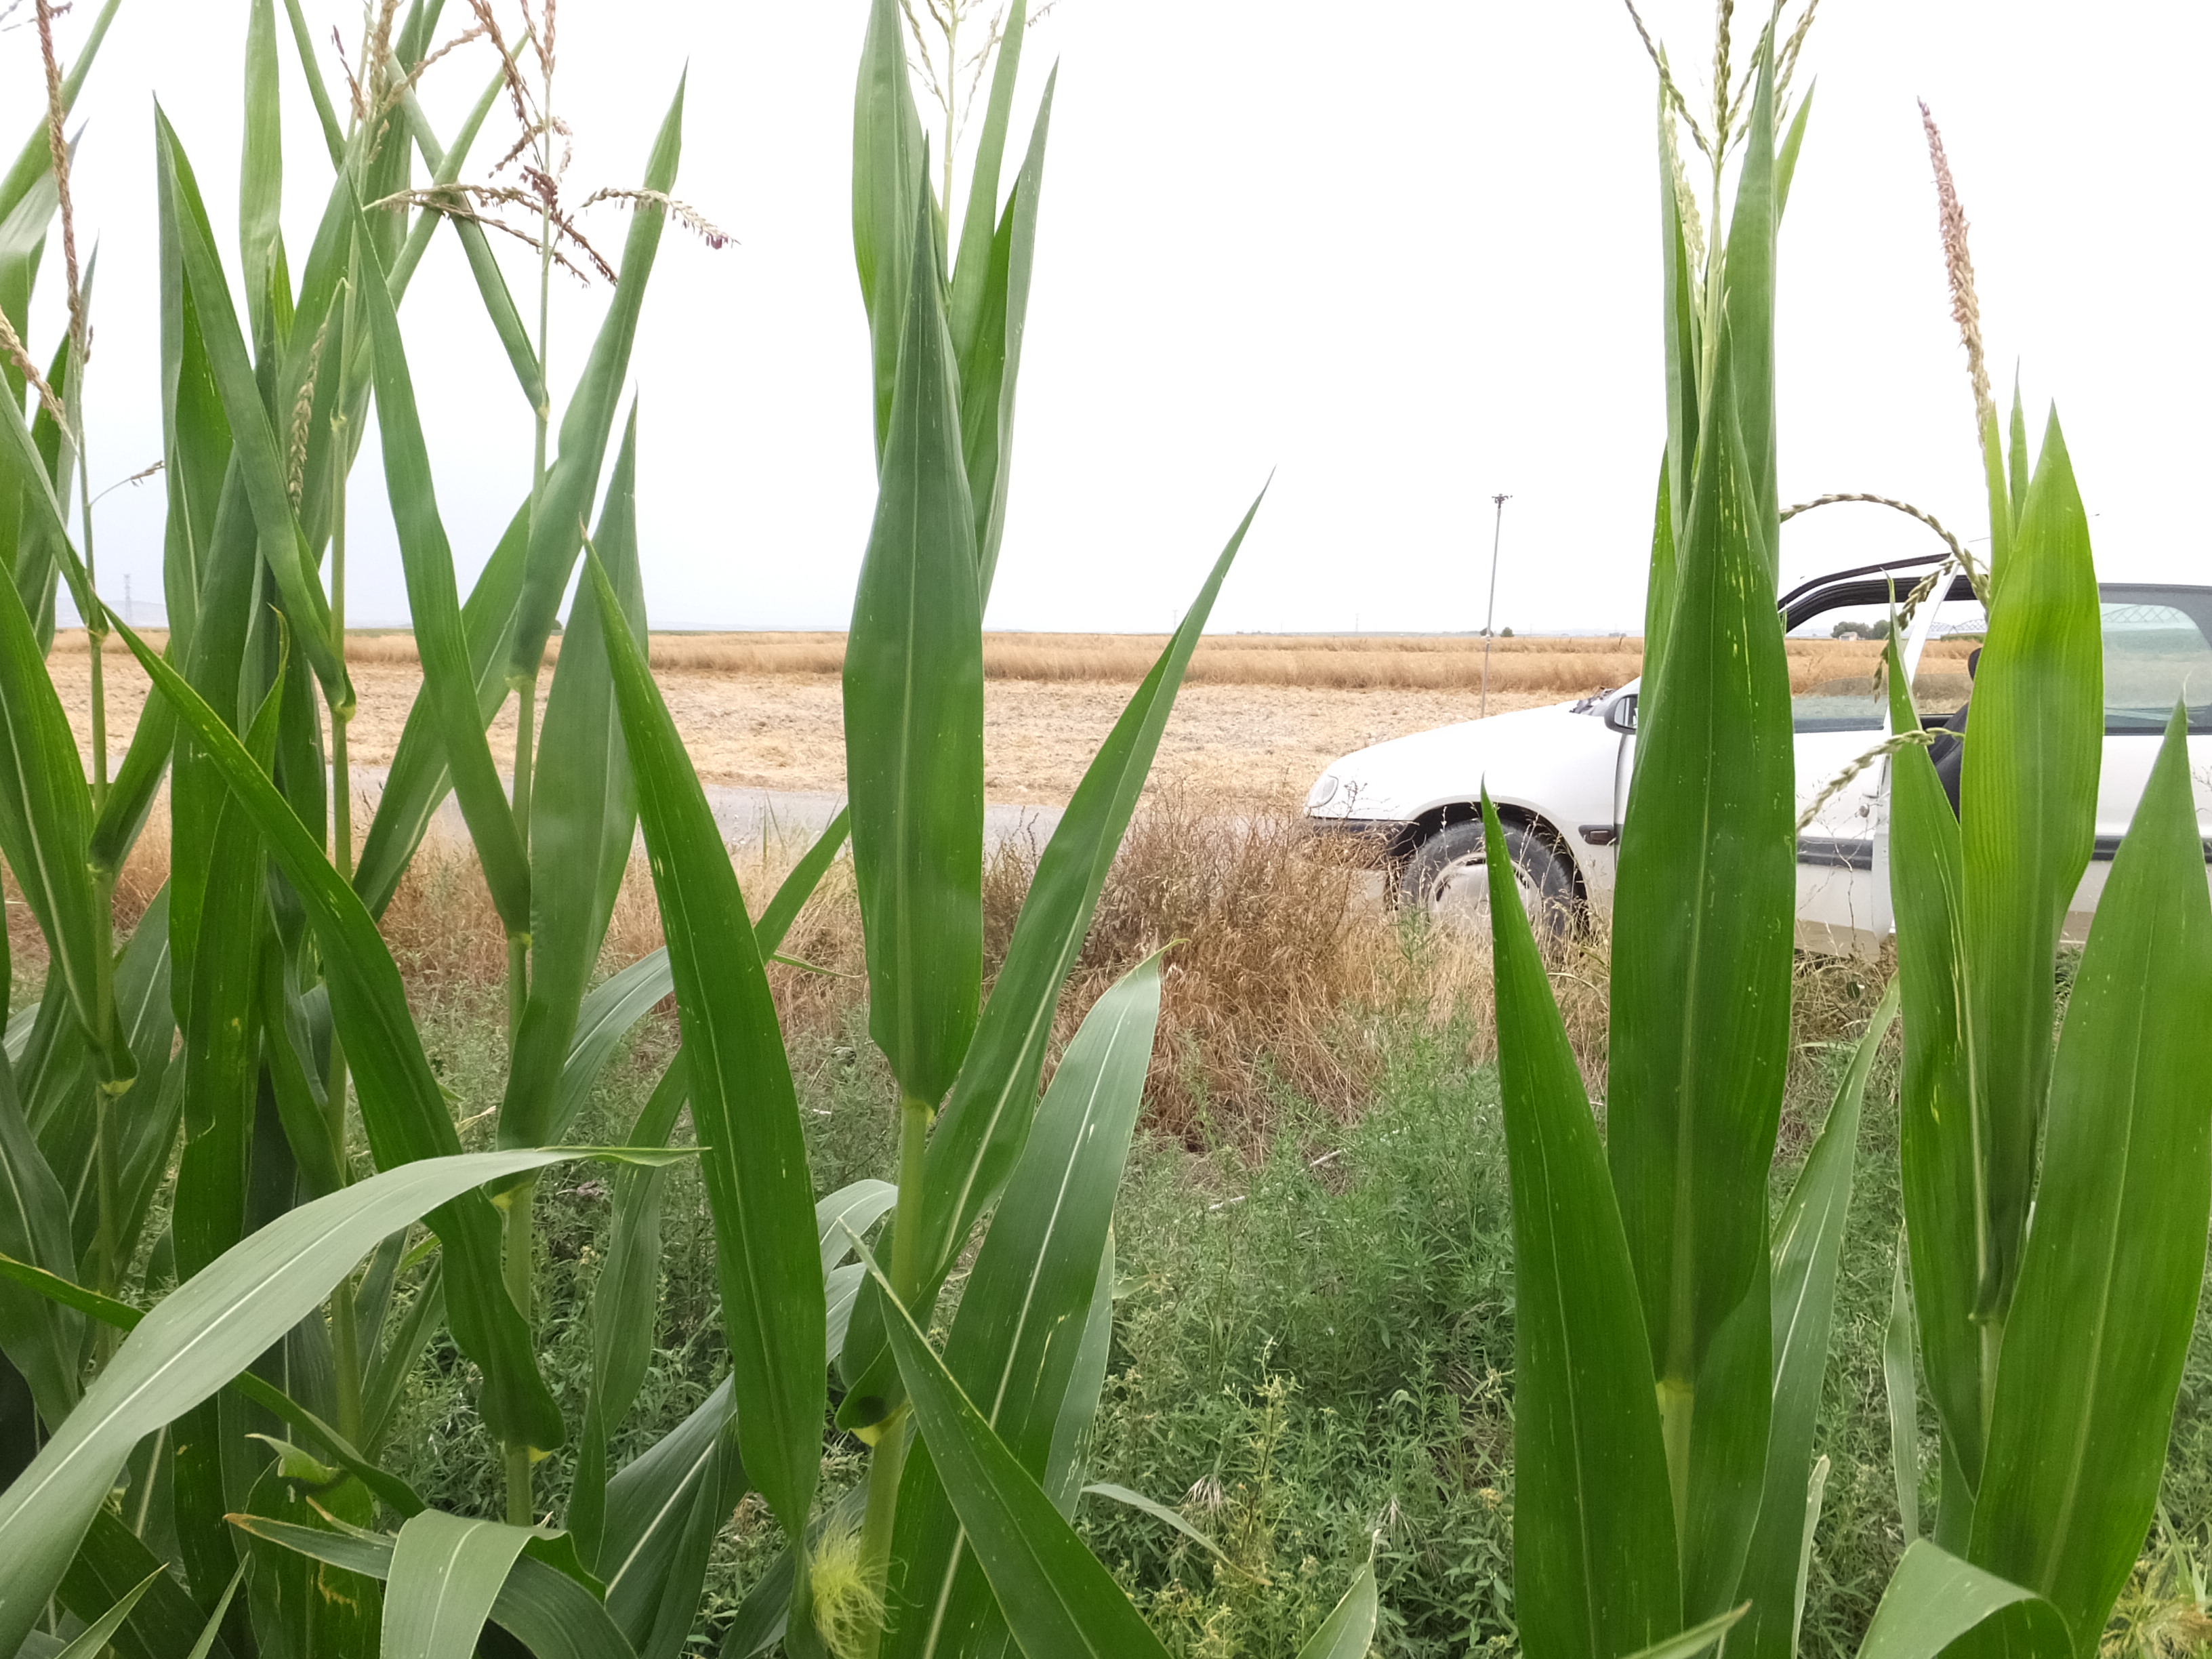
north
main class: Cropland
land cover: Maize
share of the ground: > 75 %
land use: Agriculture (excluding fallow land and kitchen gardens)
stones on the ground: < 10 %
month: July
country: ES
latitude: 41.4762
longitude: -0.0859
